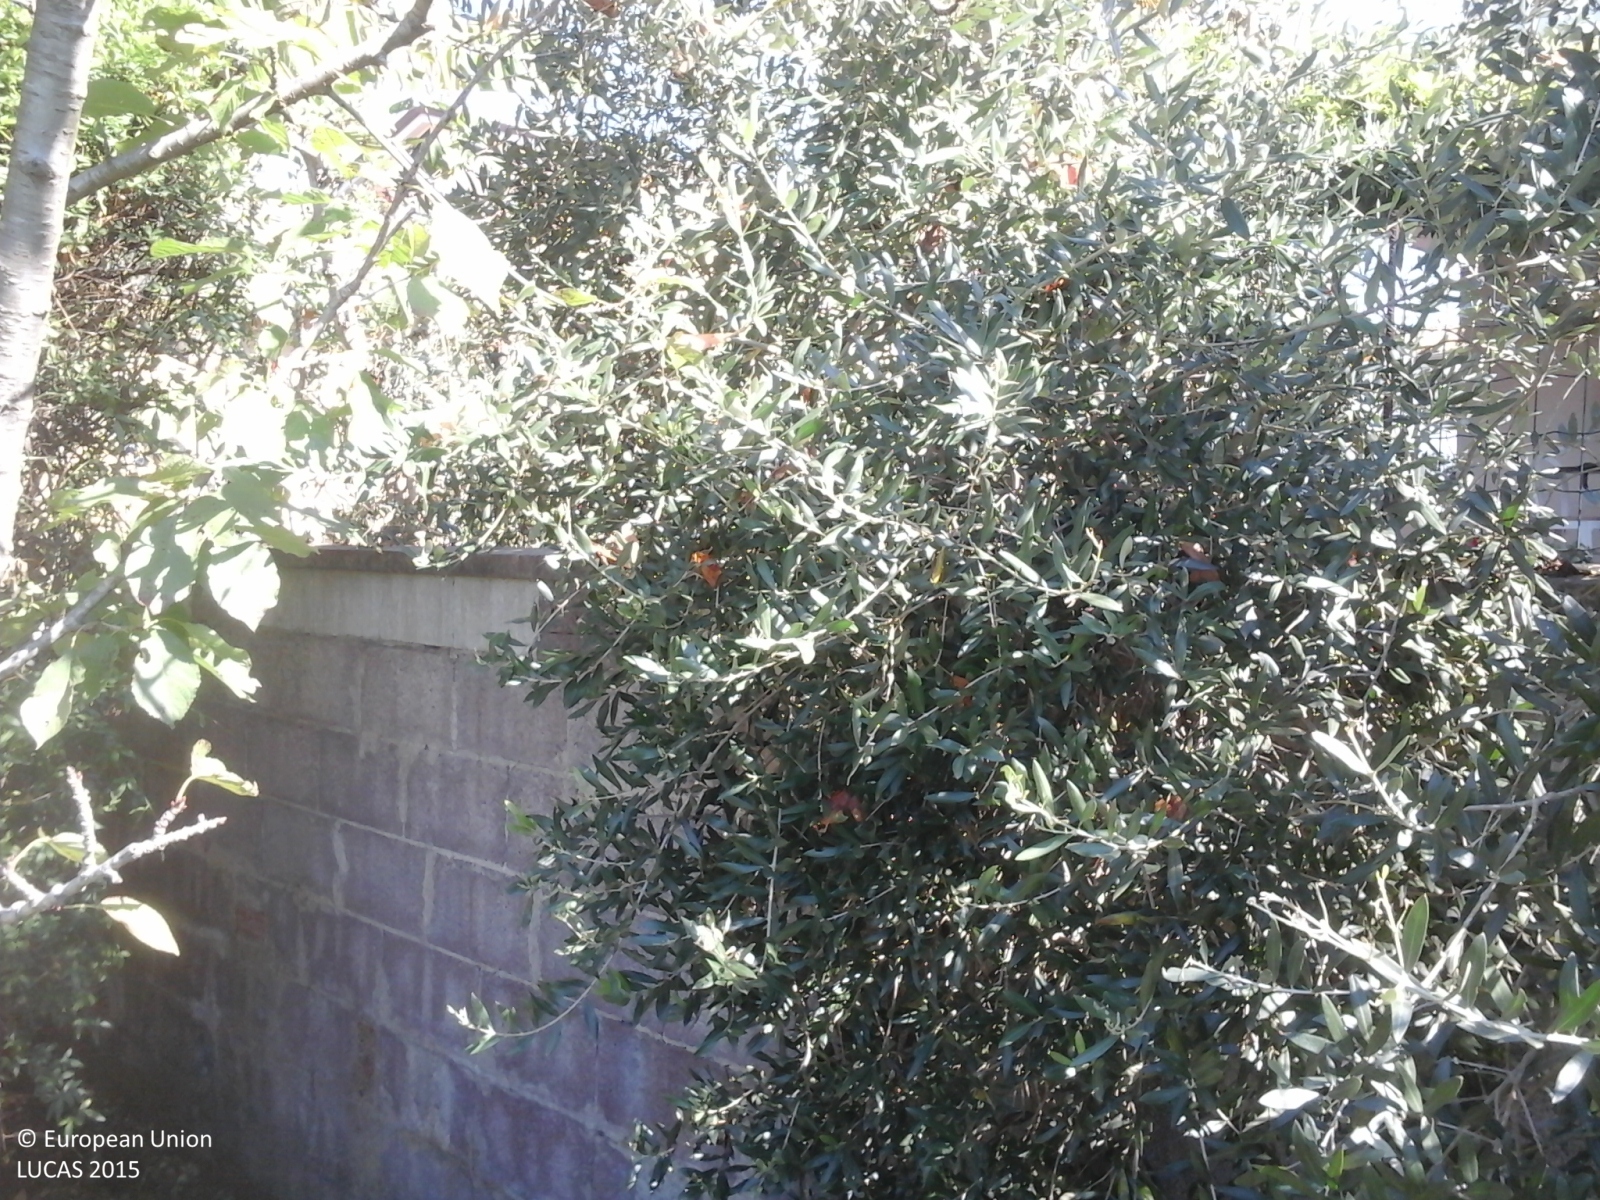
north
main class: Grassland
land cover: Grassland without tree/shrub cover
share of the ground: > 75 %
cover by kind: herbaceous plants 100 %
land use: Agriculture (excluding fallow land and kitchen gardens)
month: August
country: IT
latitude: 43.7726
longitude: 10.3593
